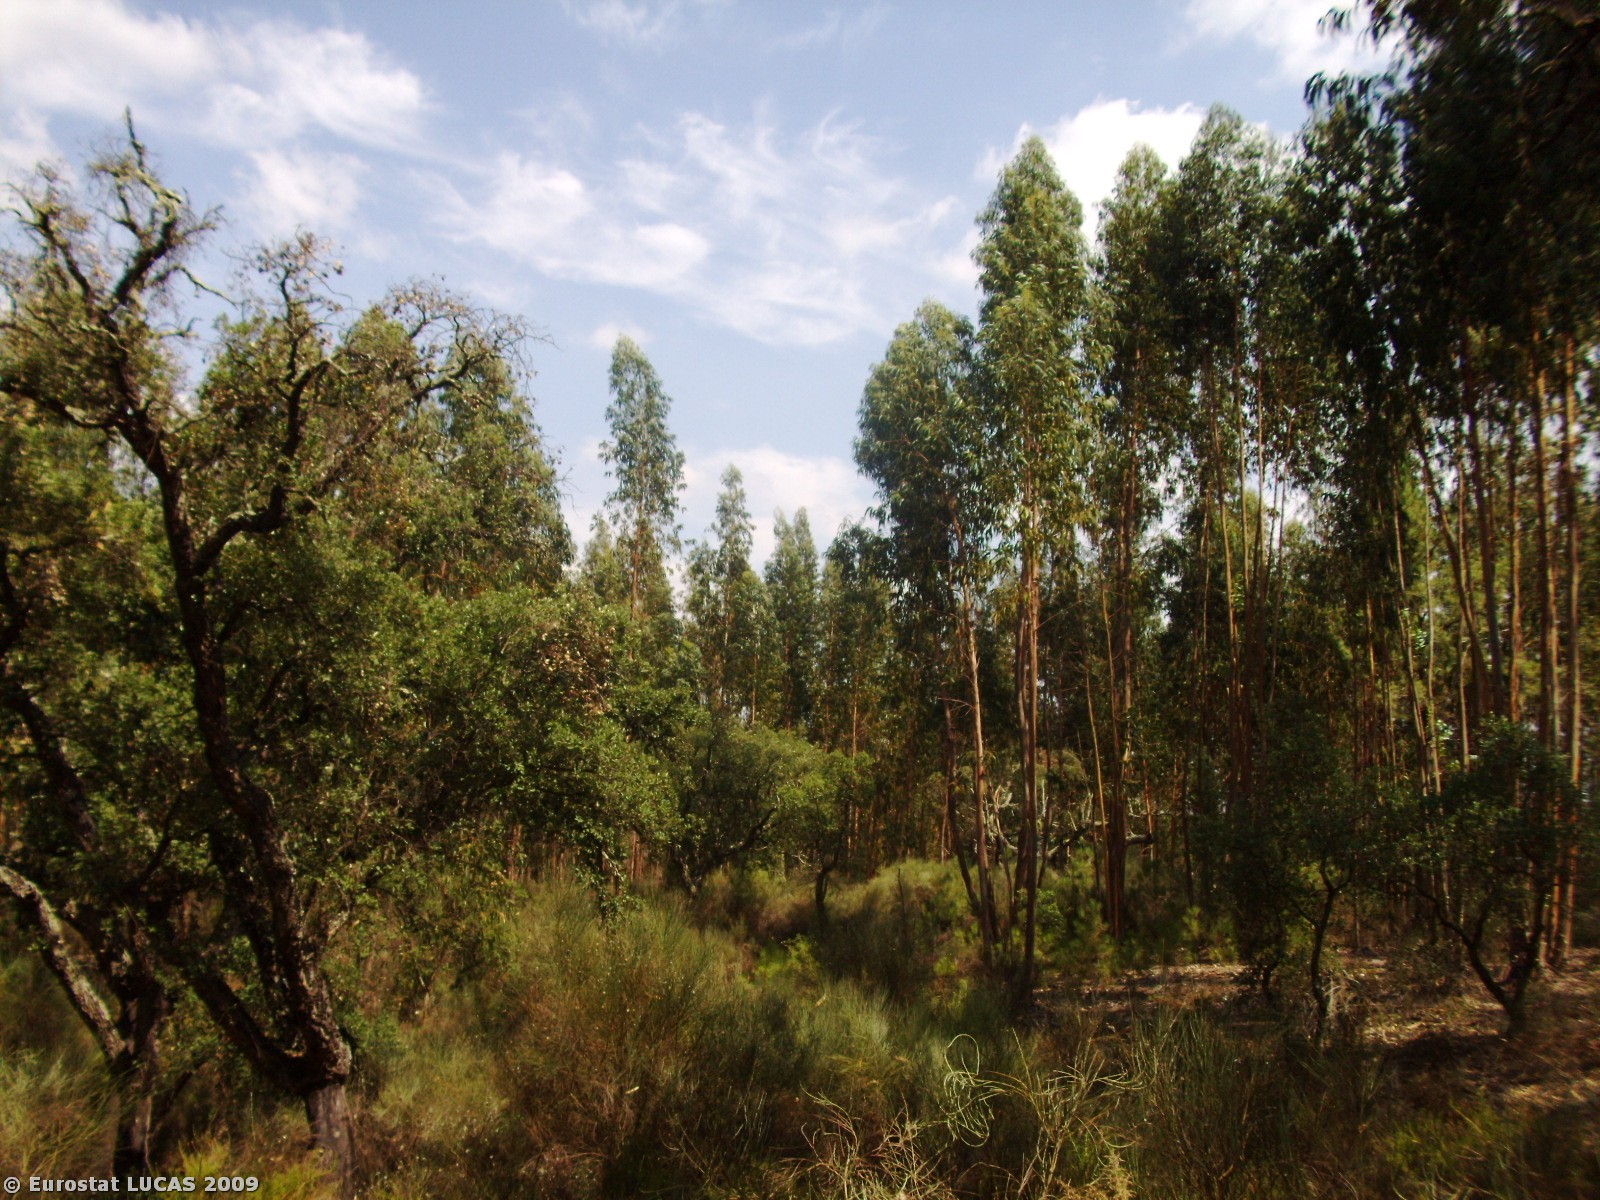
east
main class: Woodland
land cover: Broadleaved woodland
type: plantations and self-sown exotic forest
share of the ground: 50 - 75 %
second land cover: Spontaneously vegetated surfaces
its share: 10 - 25 %
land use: Forestry
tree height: > 5 m
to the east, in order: Broadleaved woodland; Spontaneously vegetated surfaces; Broadleaved woodland; Tracks; Broadleaved woodland; Rivers and streams; Broadleaved woodland
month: August
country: PT
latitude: 39.2828
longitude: -8.1321
